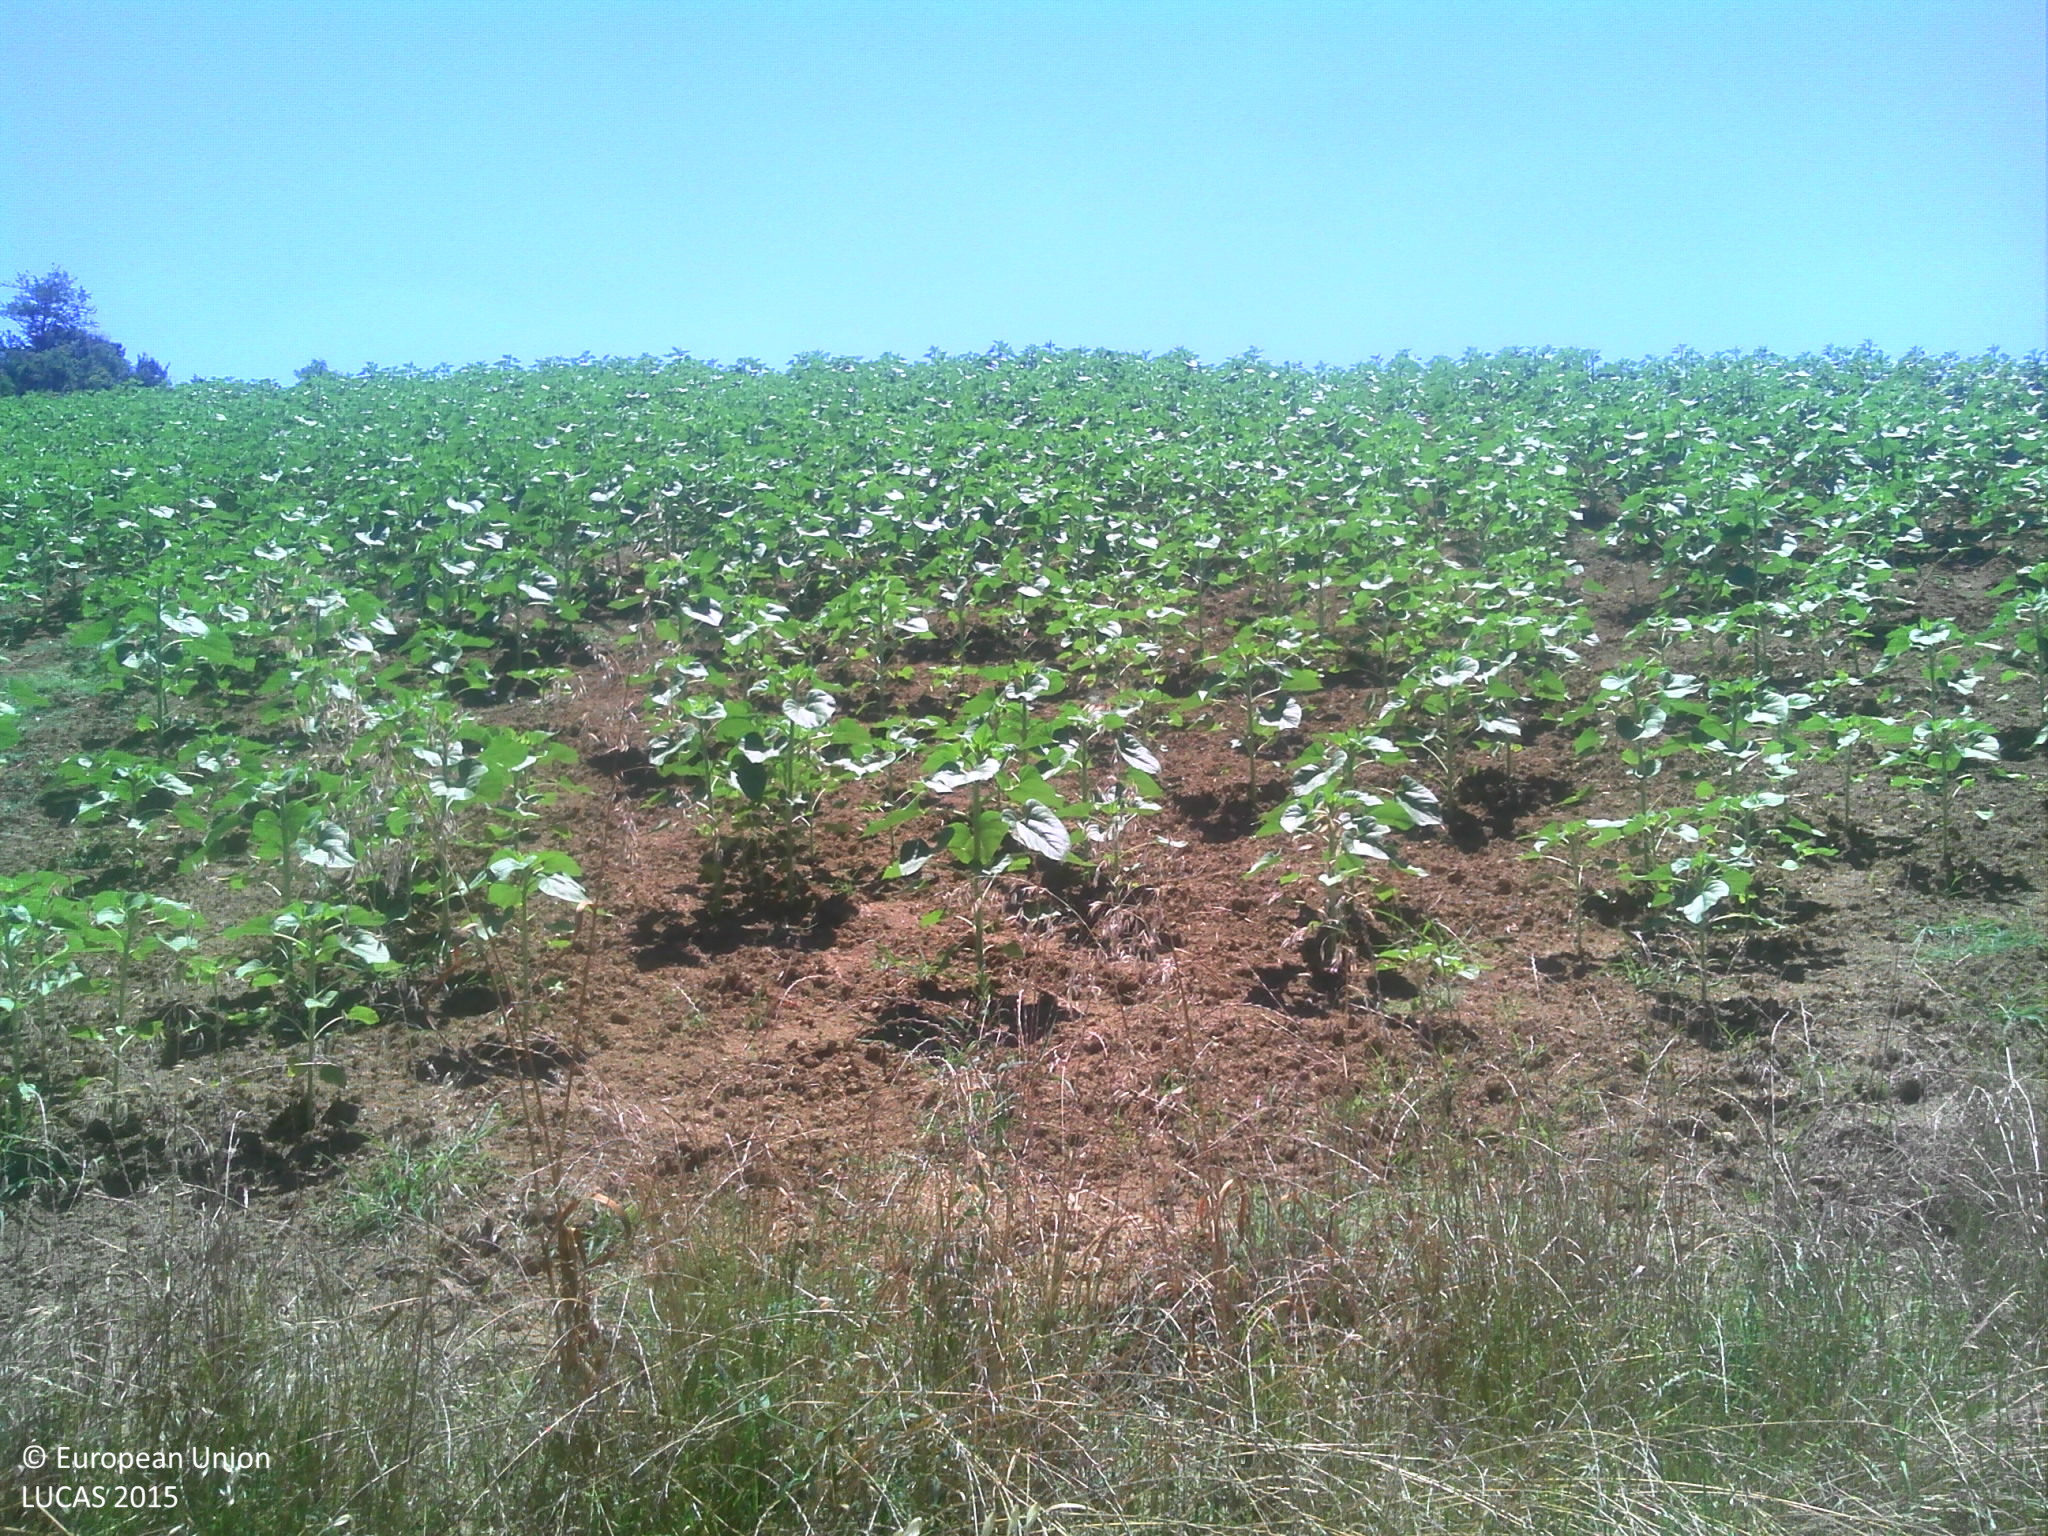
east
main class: Shrubland
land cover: Shrubland without tree cover
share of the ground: > 75 %
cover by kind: shrubs 100 %
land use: Semi-natural and natural areas not in use
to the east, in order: Shrubland without tree cover; Tracks; Sunflower; Grass margins; Broadleaved woodland; Tracks; Broadleaved woodland; Grass margins; Common wheat; Grass margins; Broadleaved woodland
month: July
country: FR
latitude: 43.4724
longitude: 1.0390
